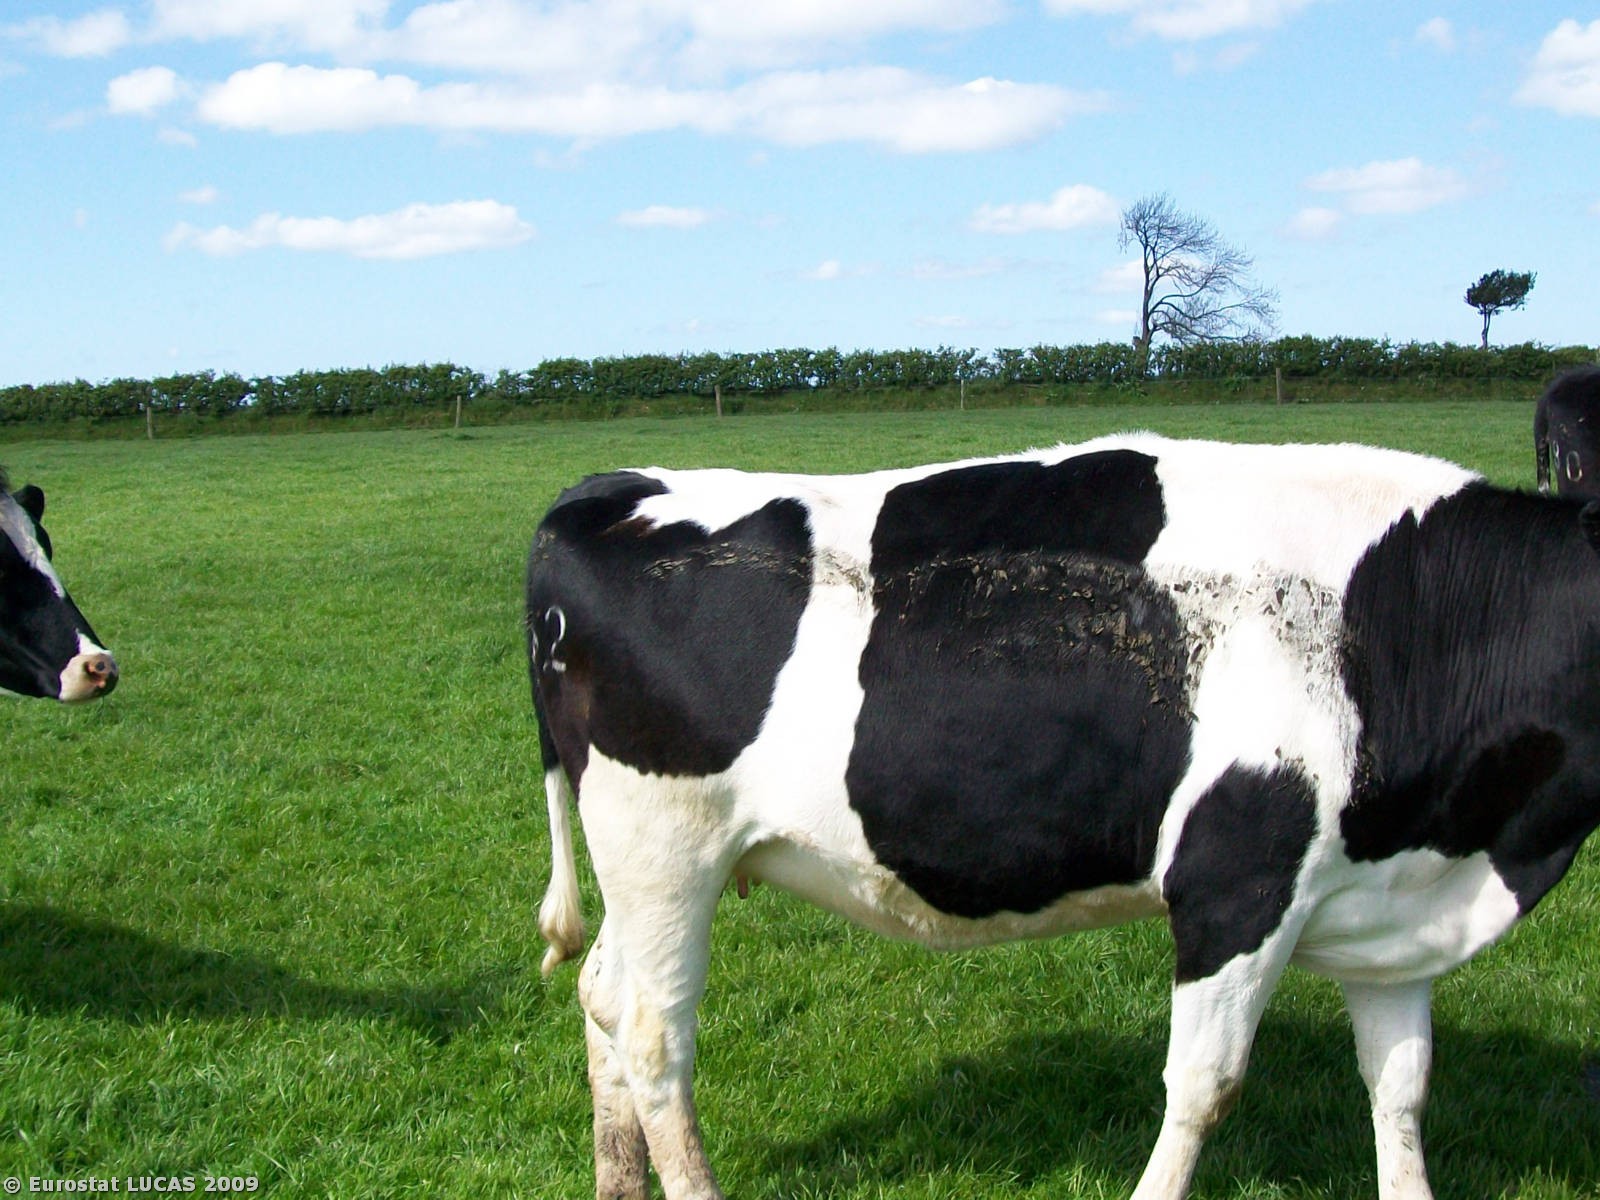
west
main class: Grassland
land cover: Grassland without tree/shrub cover
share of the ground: > 75 %
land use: Agriculture (excluding fallow land and kitchen gardens)
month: May
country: GB
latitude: 54.8063
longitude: -3.2224
